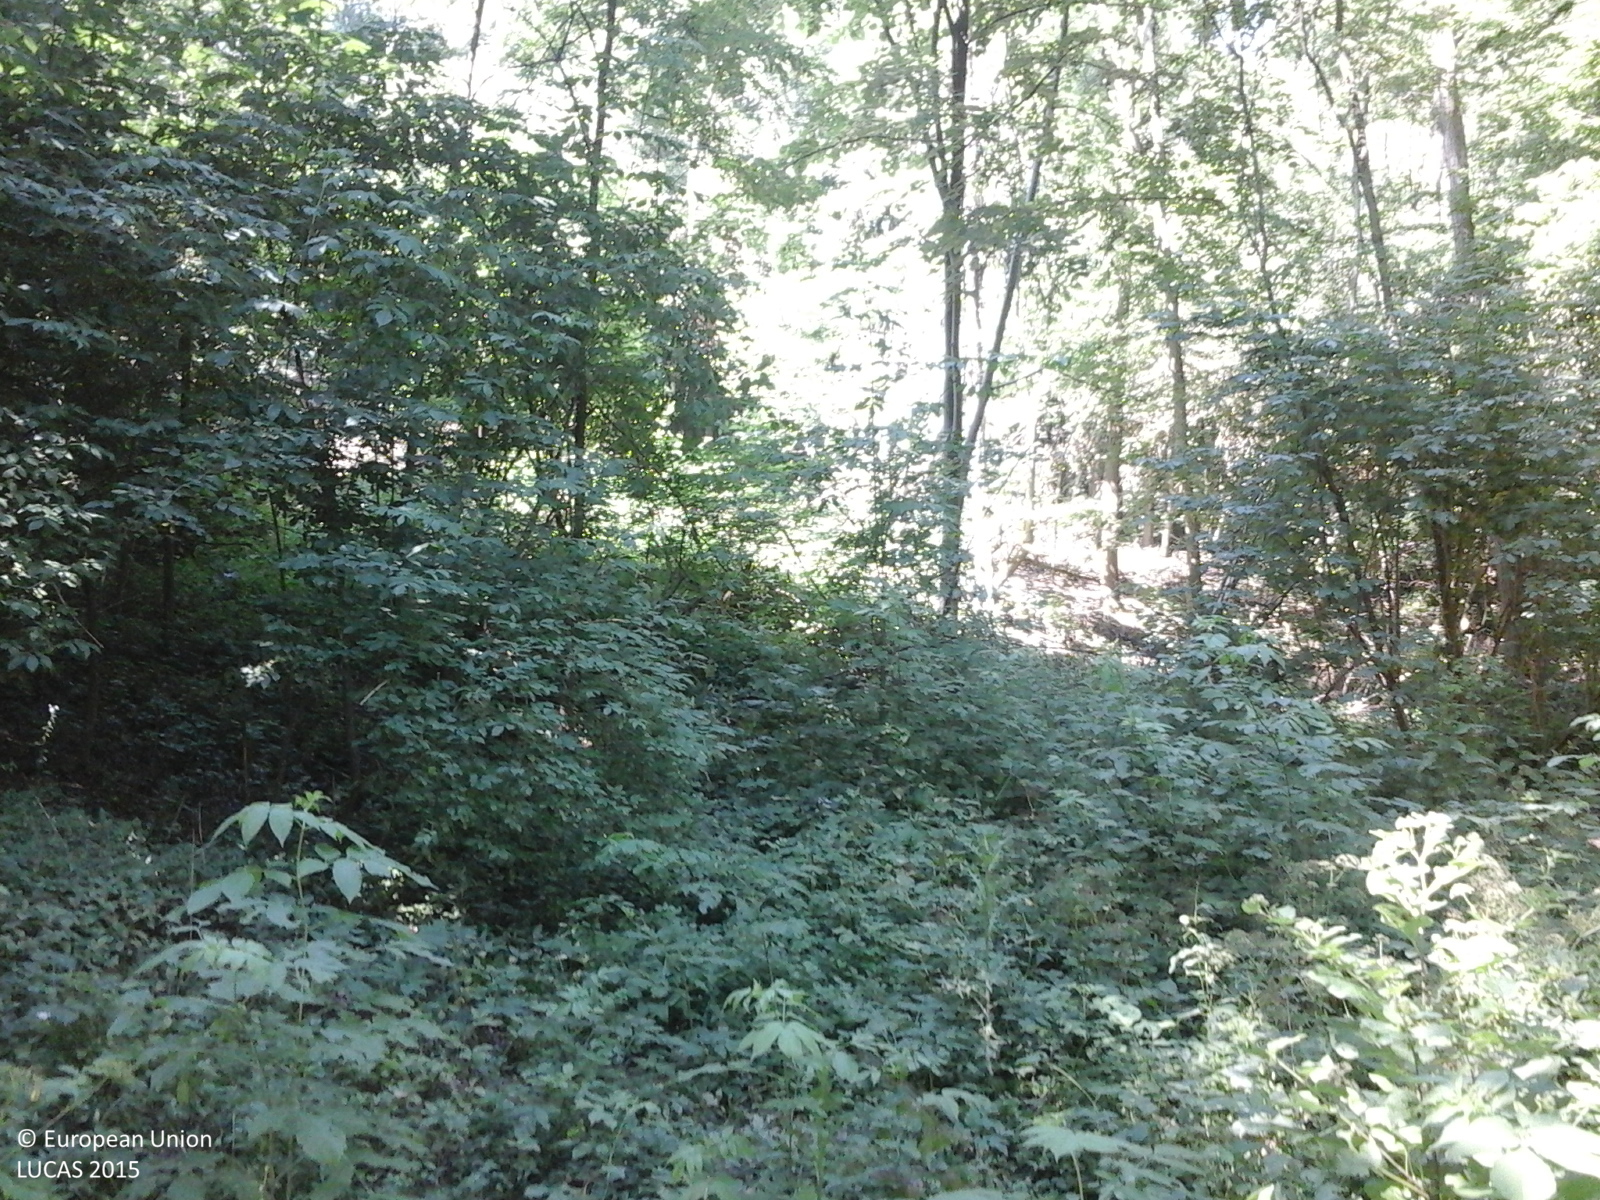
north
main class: Woodland
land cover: Broadleaved woodland
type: beech forest
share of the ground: > 75 %
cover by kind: broadleaved forest trees 80 %, herbaceous plants 15 %, shrubs 5 %
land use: Forestry
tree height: > 5 m
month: July
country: RO
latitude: 44.5889
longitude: 24.3659
